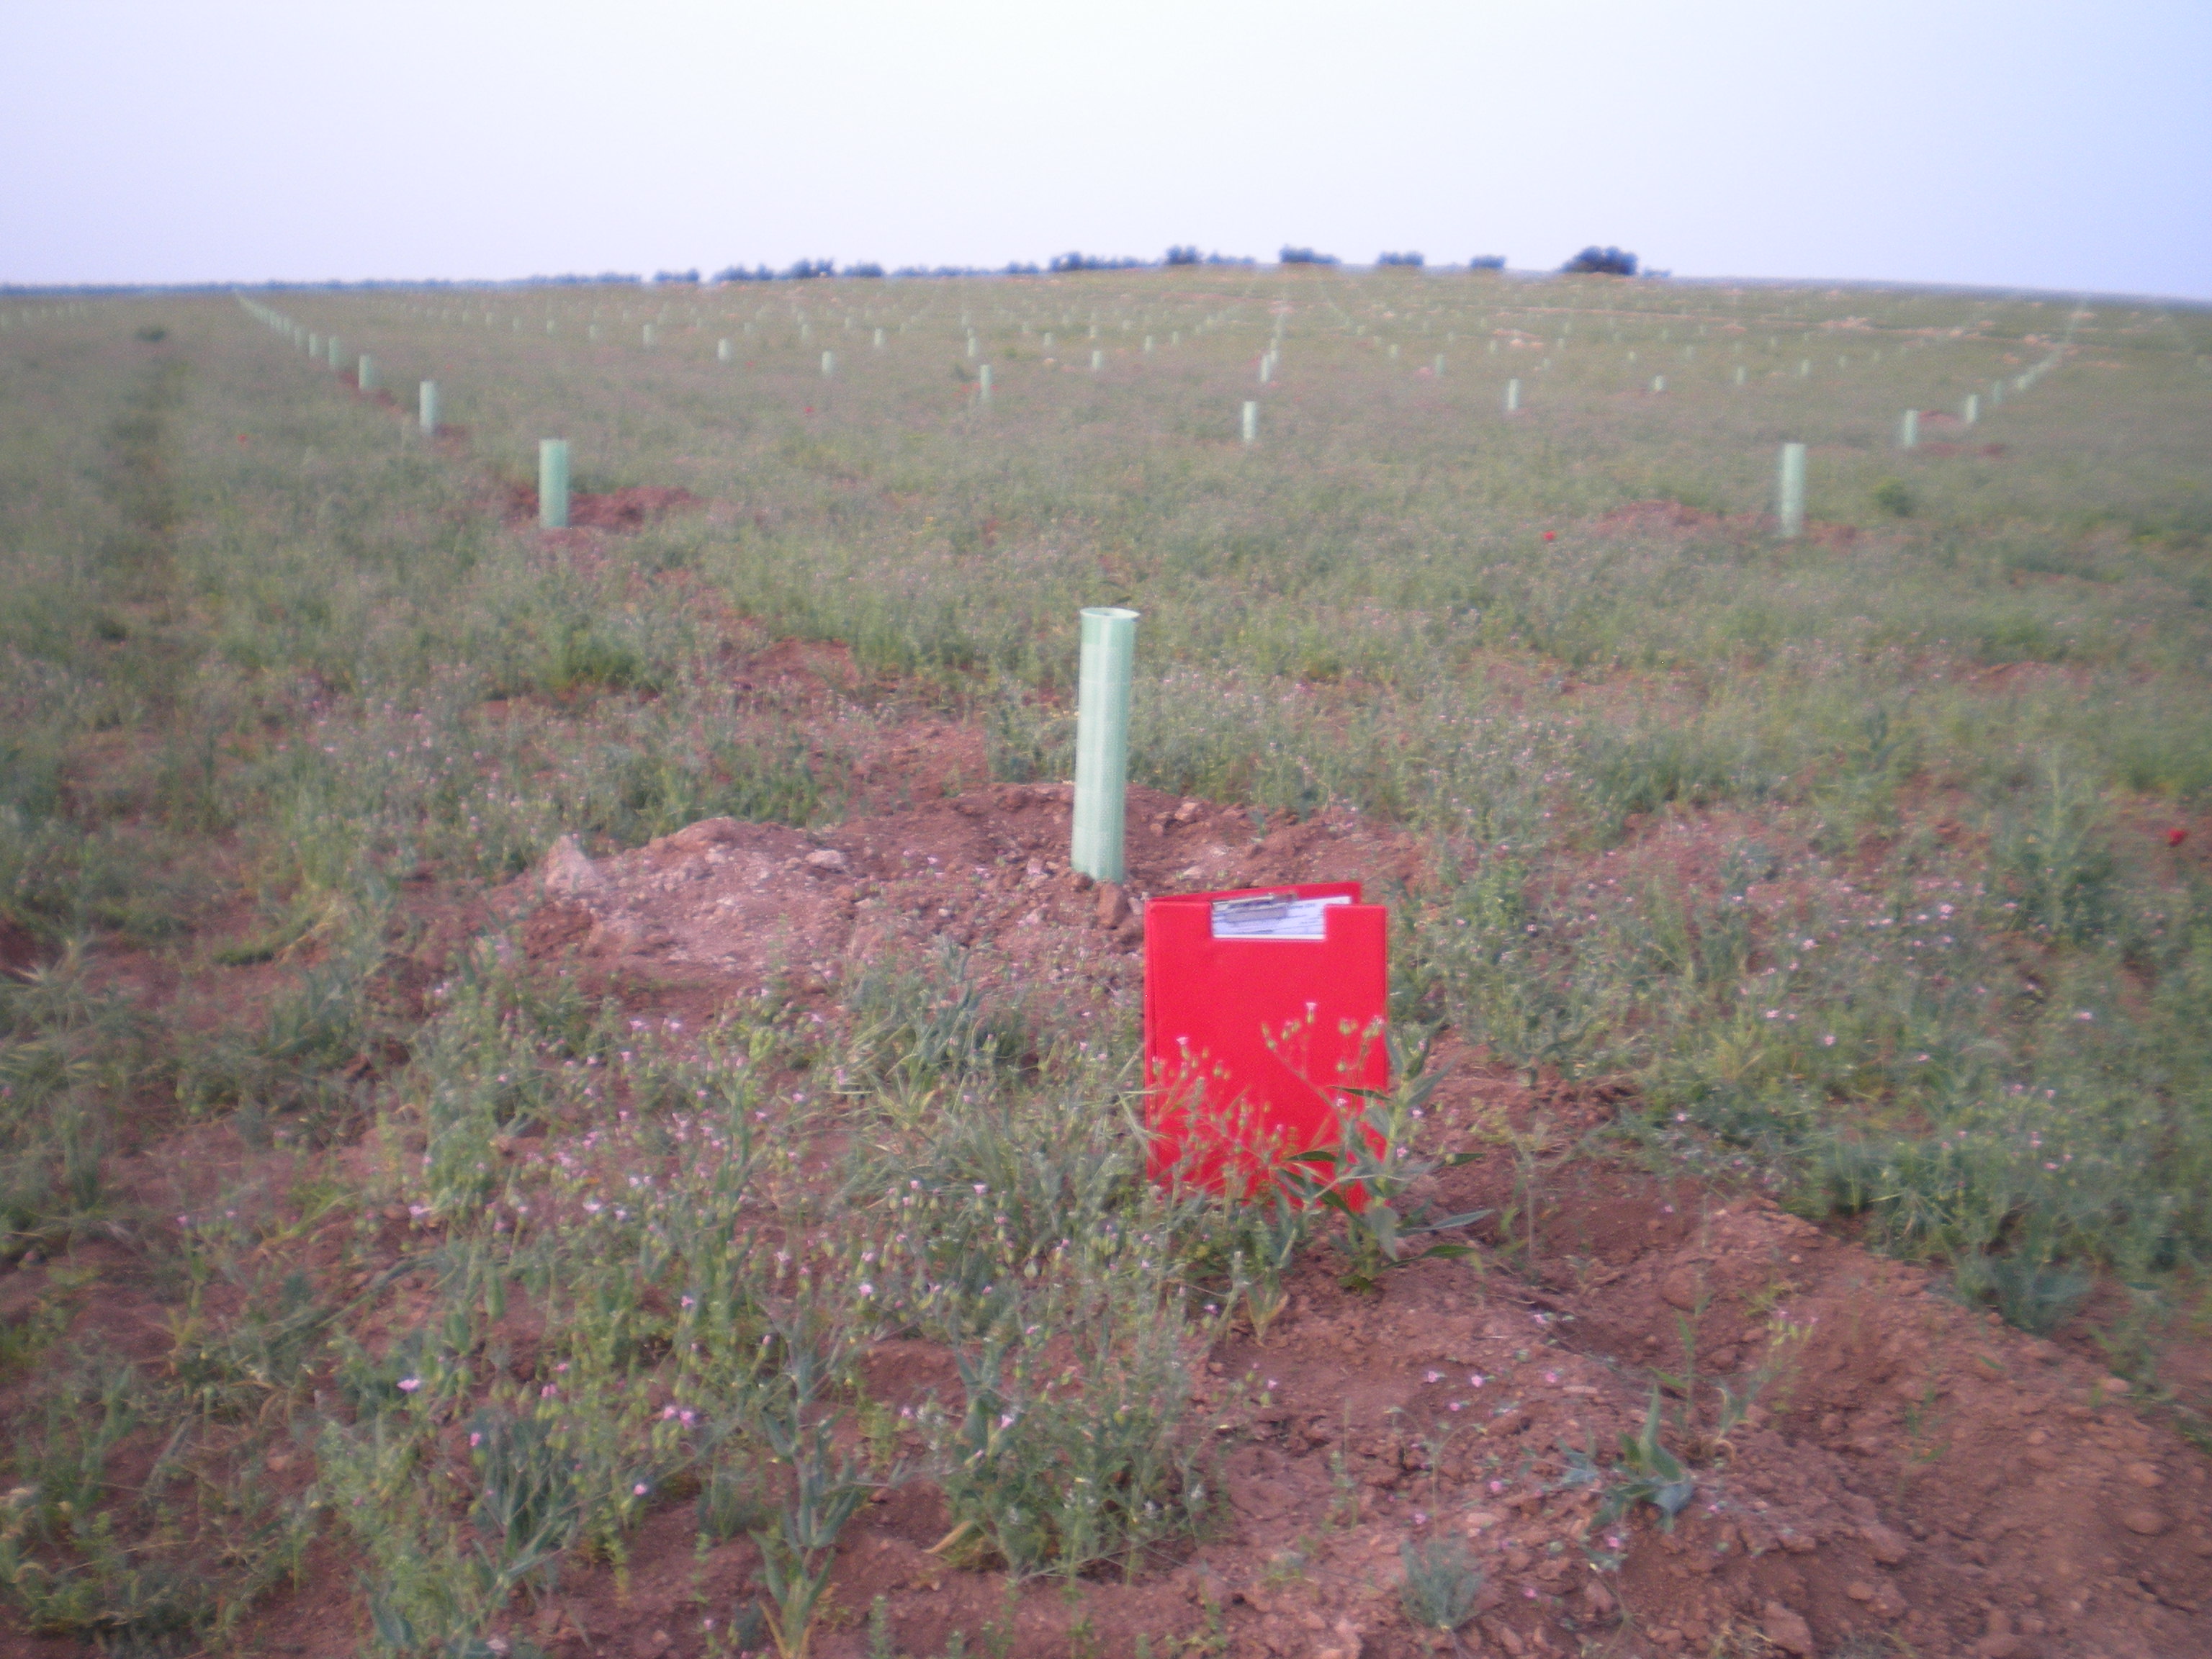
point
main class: Cropland
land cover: Nuts trees
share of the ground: < 10 %
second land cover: Spontaneously vegetated surfaces
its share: 50 - 75 %
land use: Agriculture (excluding fallow land and kitchen gardens)
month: May
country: ES
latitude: 39.0670
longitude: -3.0137
